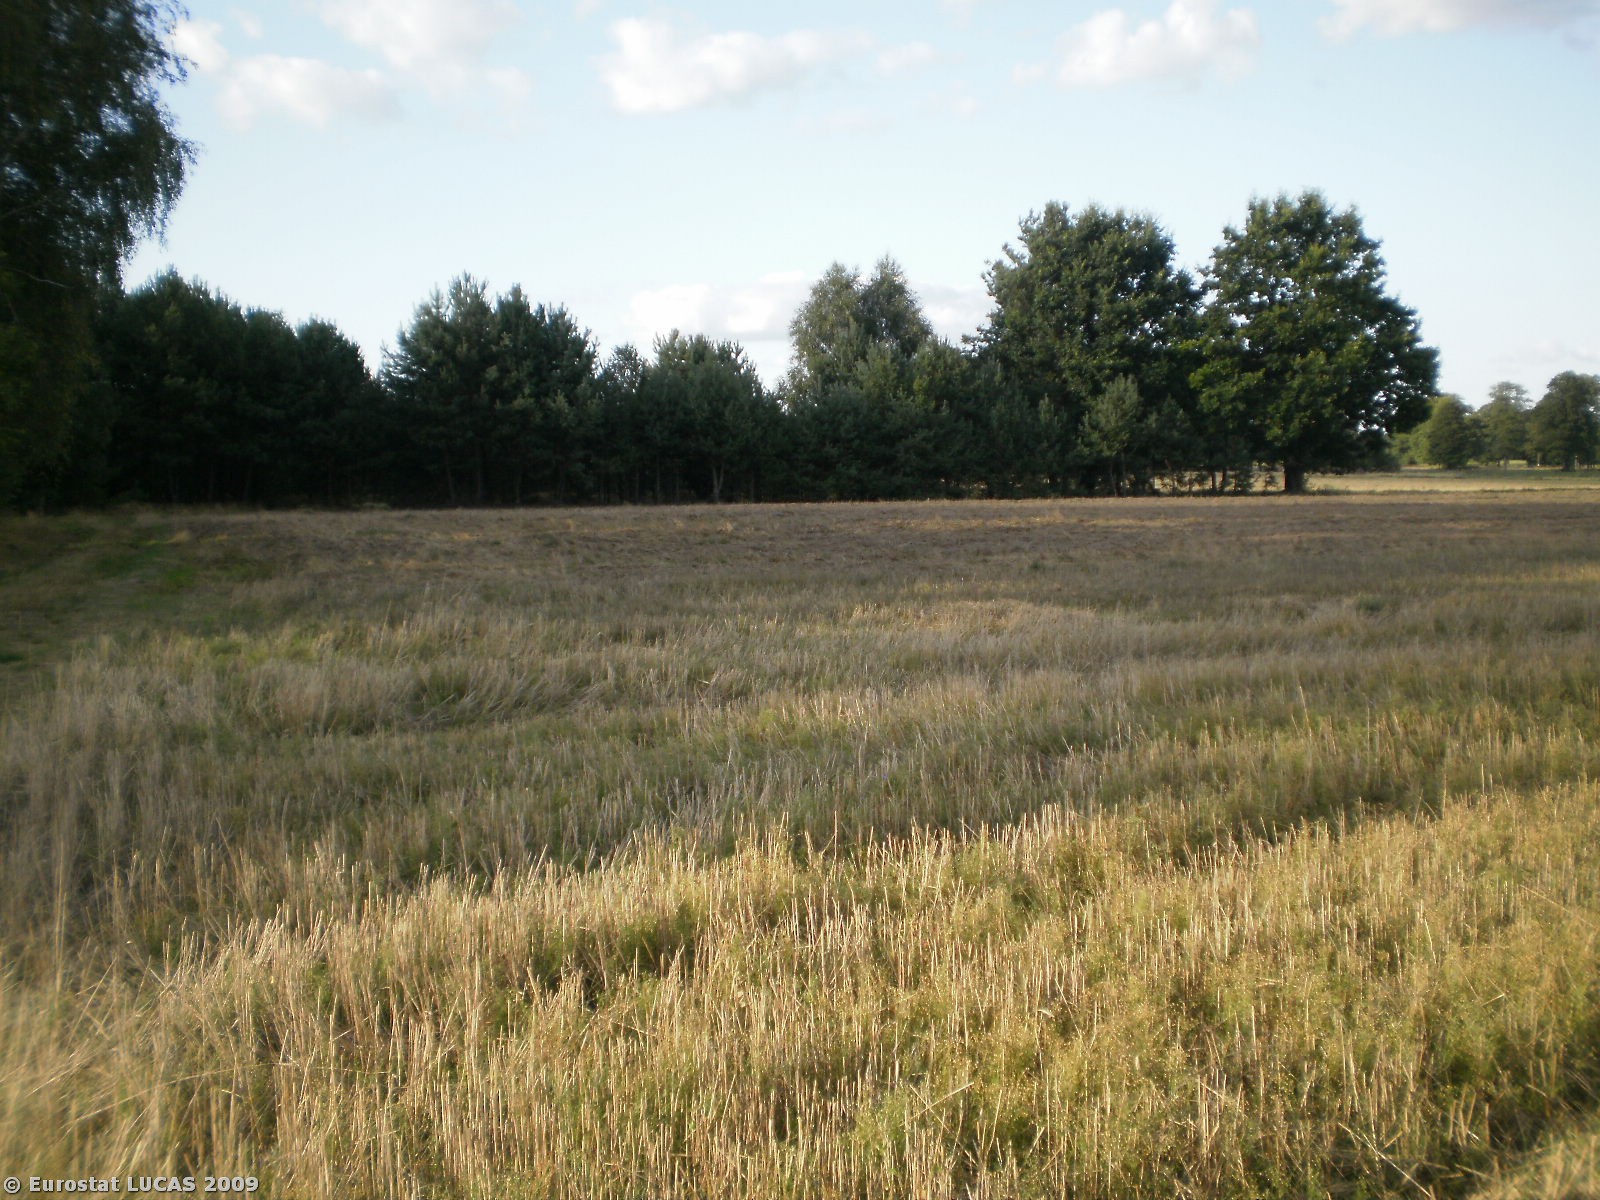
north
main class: Cropland
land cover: Rye
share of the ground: < 10 %
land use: Agriculture (excluding fallow land and kitchen gardens)
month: August
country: PL
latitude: 52.7319
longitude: 21.7986
